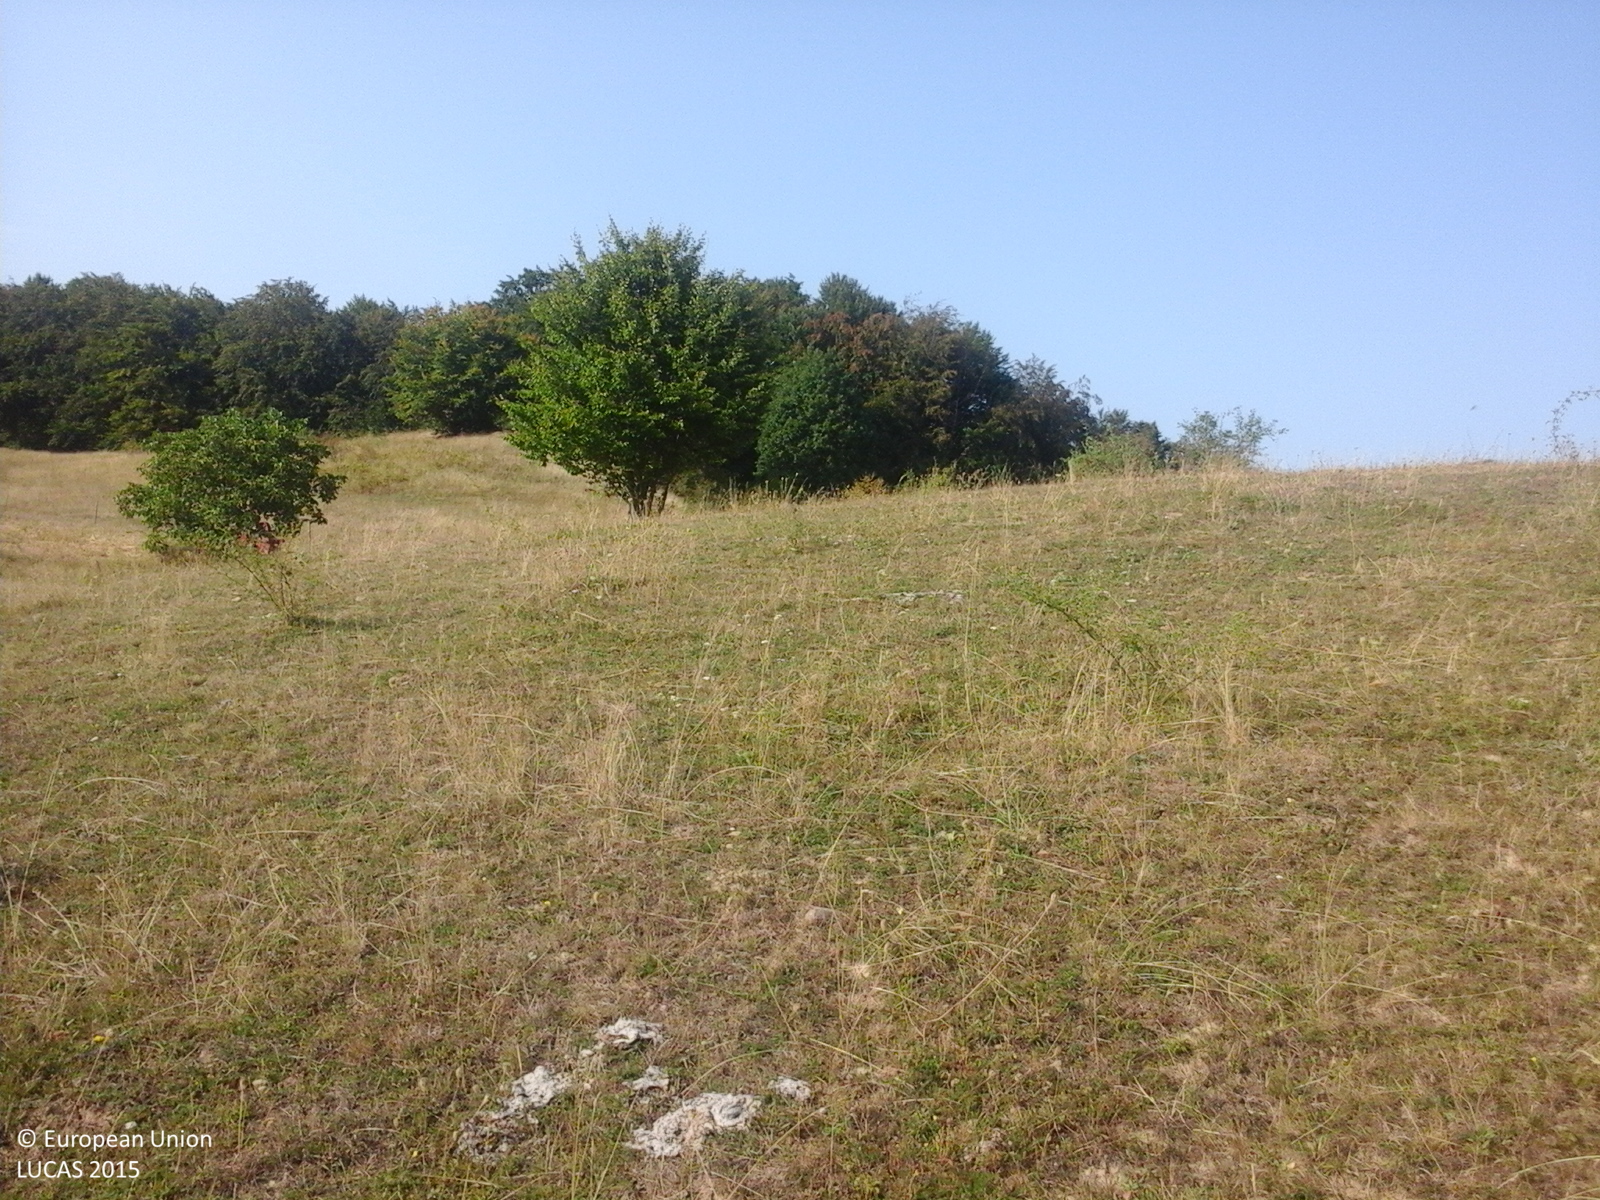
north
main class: Grassland
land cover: Grassland without tree/shrub cover
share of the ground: > 75 %
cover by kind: herbaceous plants 100 %
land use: Agriculture (excluding fallow land and kitchen gardens)
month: September
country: RO
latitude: 47.3193
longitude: 24.0406
